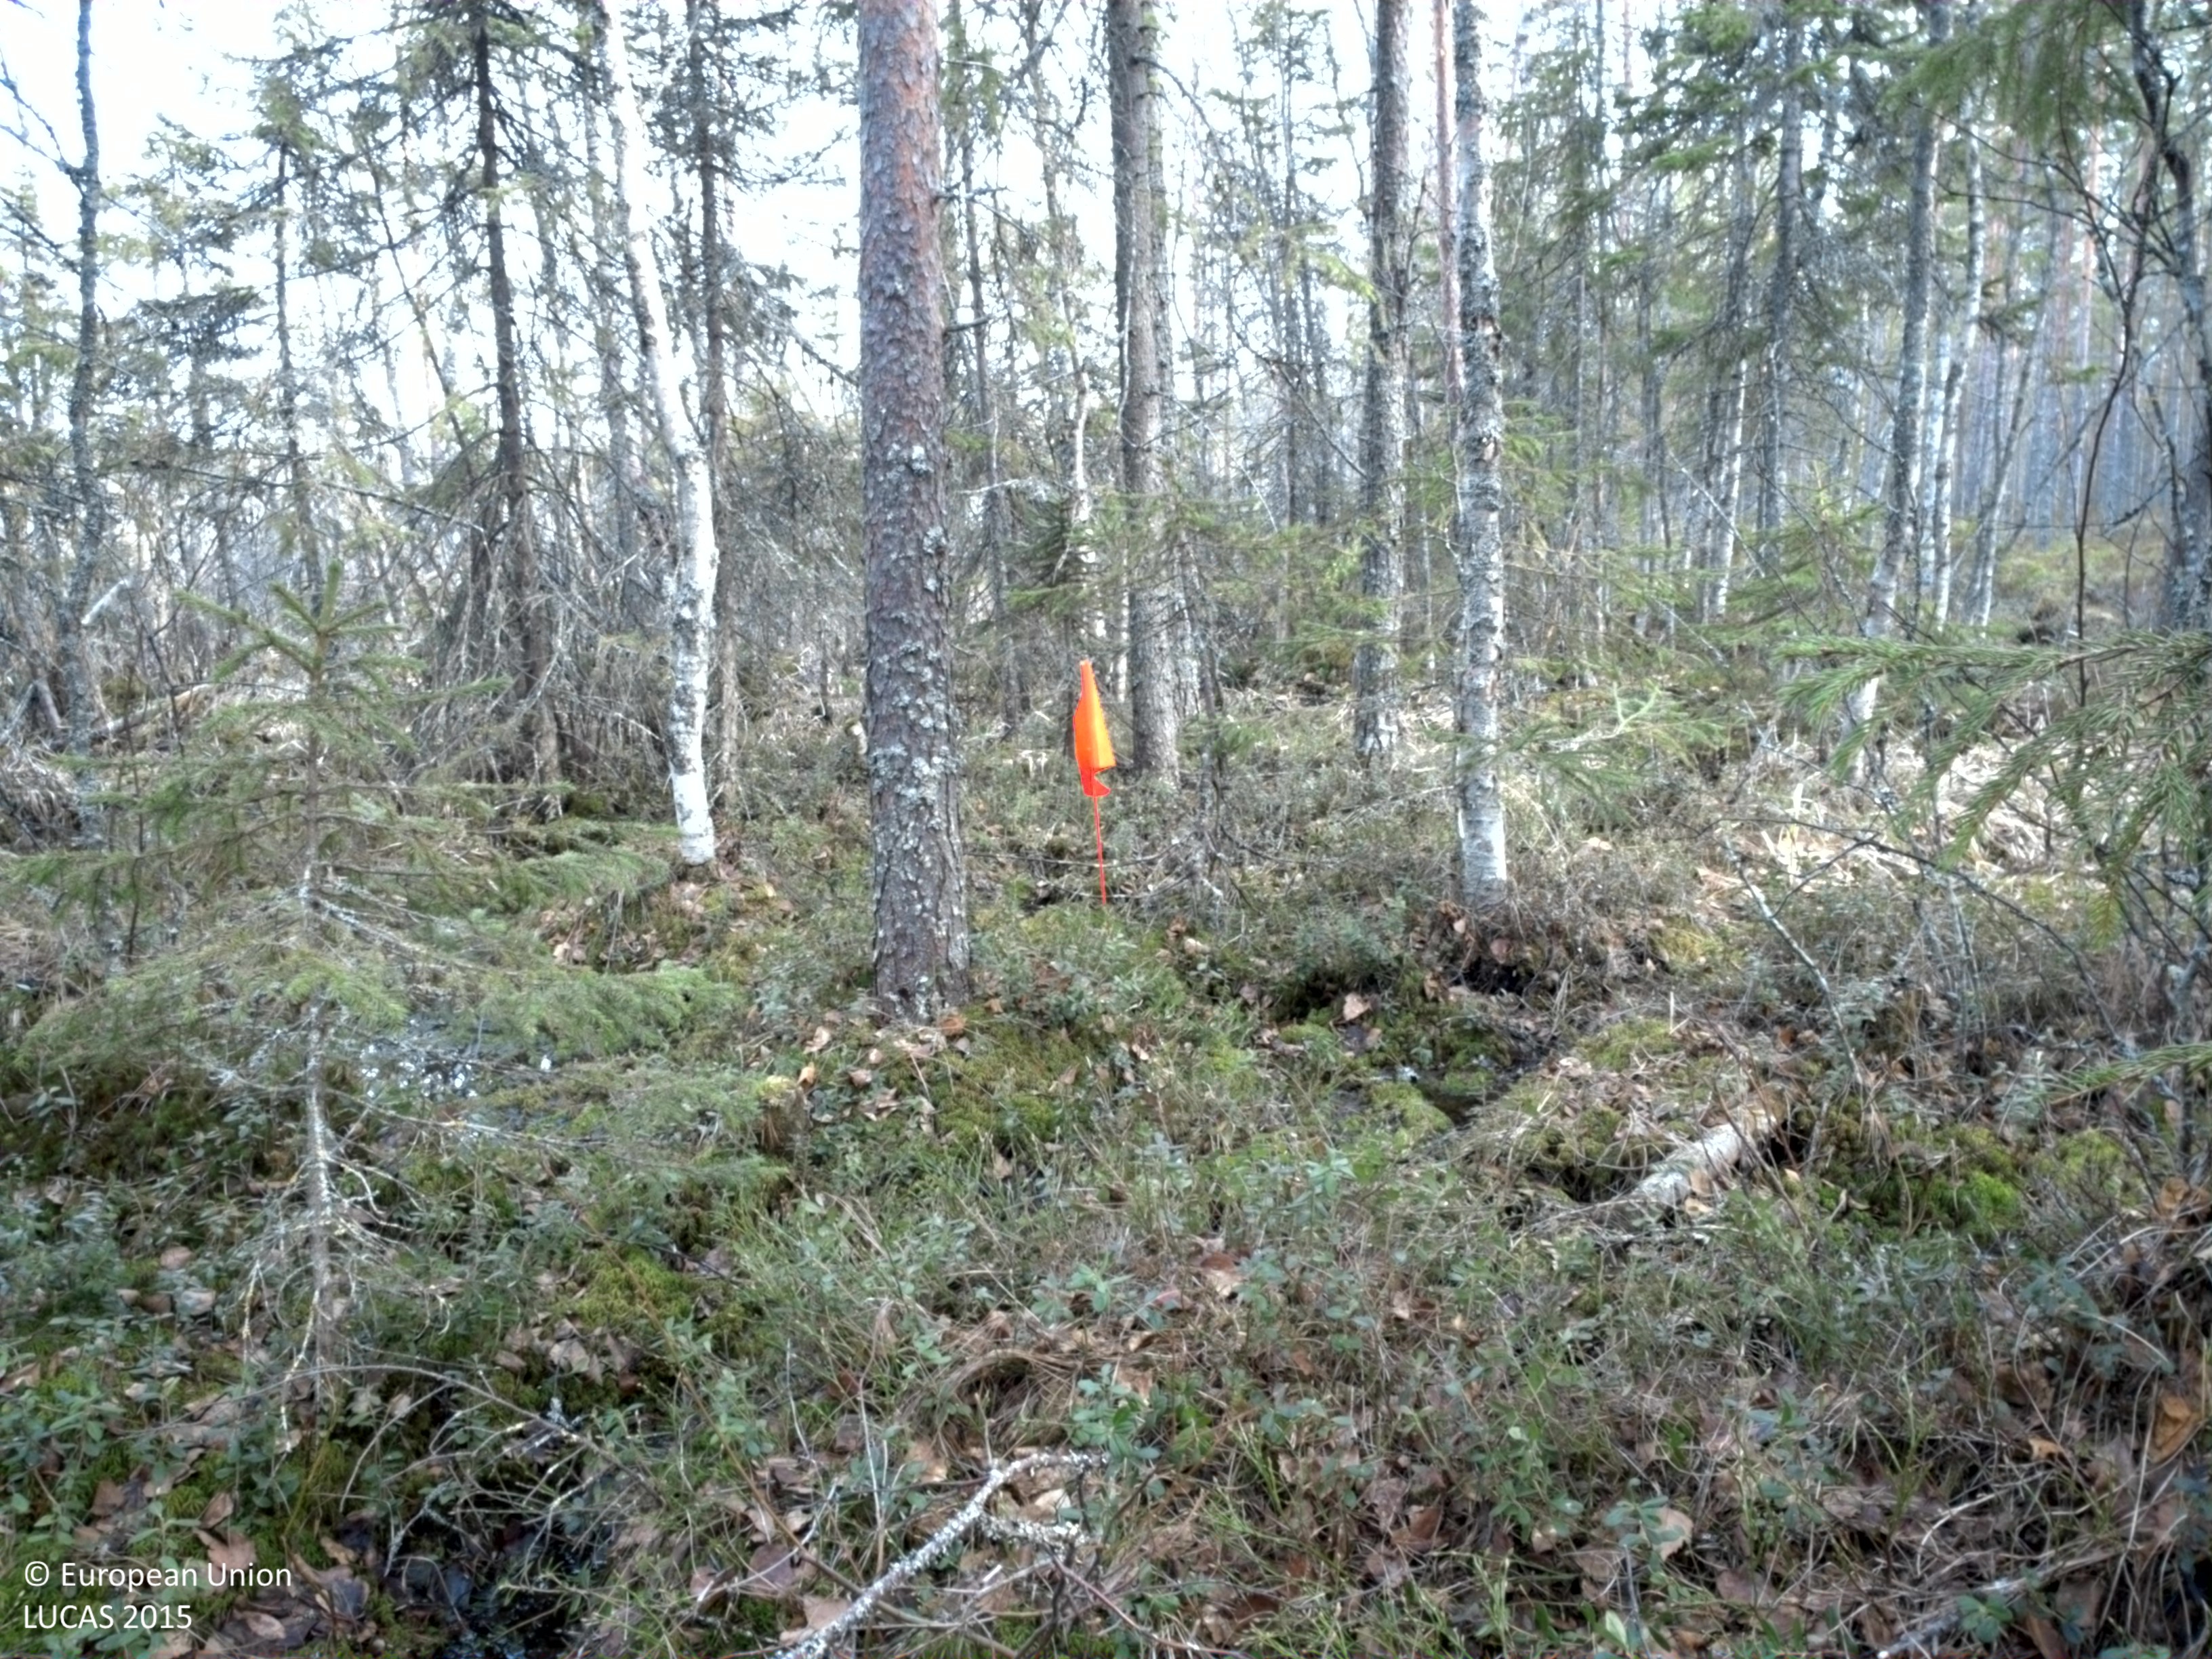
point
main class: Woodland
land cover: Pine dominated mixed woodland
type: mire and swamp forests
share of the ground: > 75 %
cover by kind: coniferous forest trees 65 %, broadleaved forest trees 25 %, shrubs 10 %
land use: Forestry
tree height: > 5 m
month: May
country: SE
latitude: 65.8484
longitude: 23.6409
